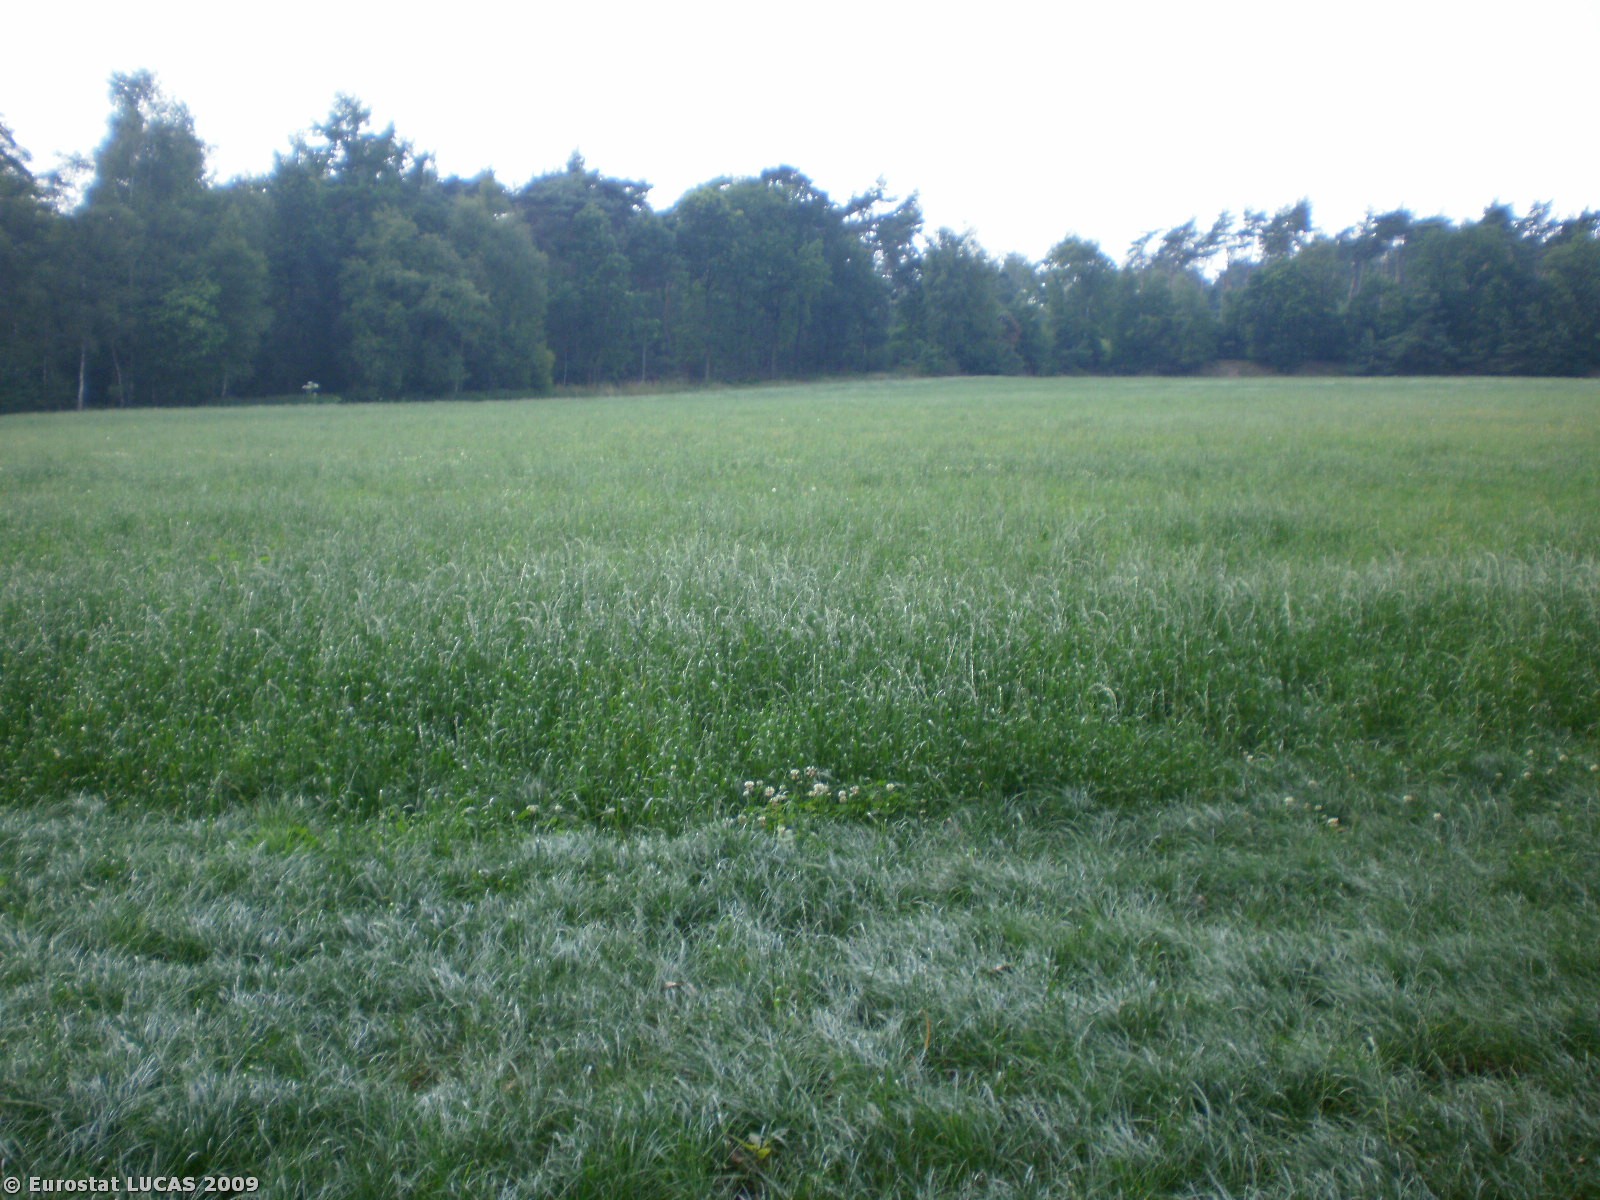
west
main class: Grassland
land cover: Grassland without tree/shrub cover
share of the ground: > 75 %
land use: Agriculture (excluding fallow land and kitchen gardens)
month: July
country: BE
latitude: 51.1555
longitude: 5.4371
